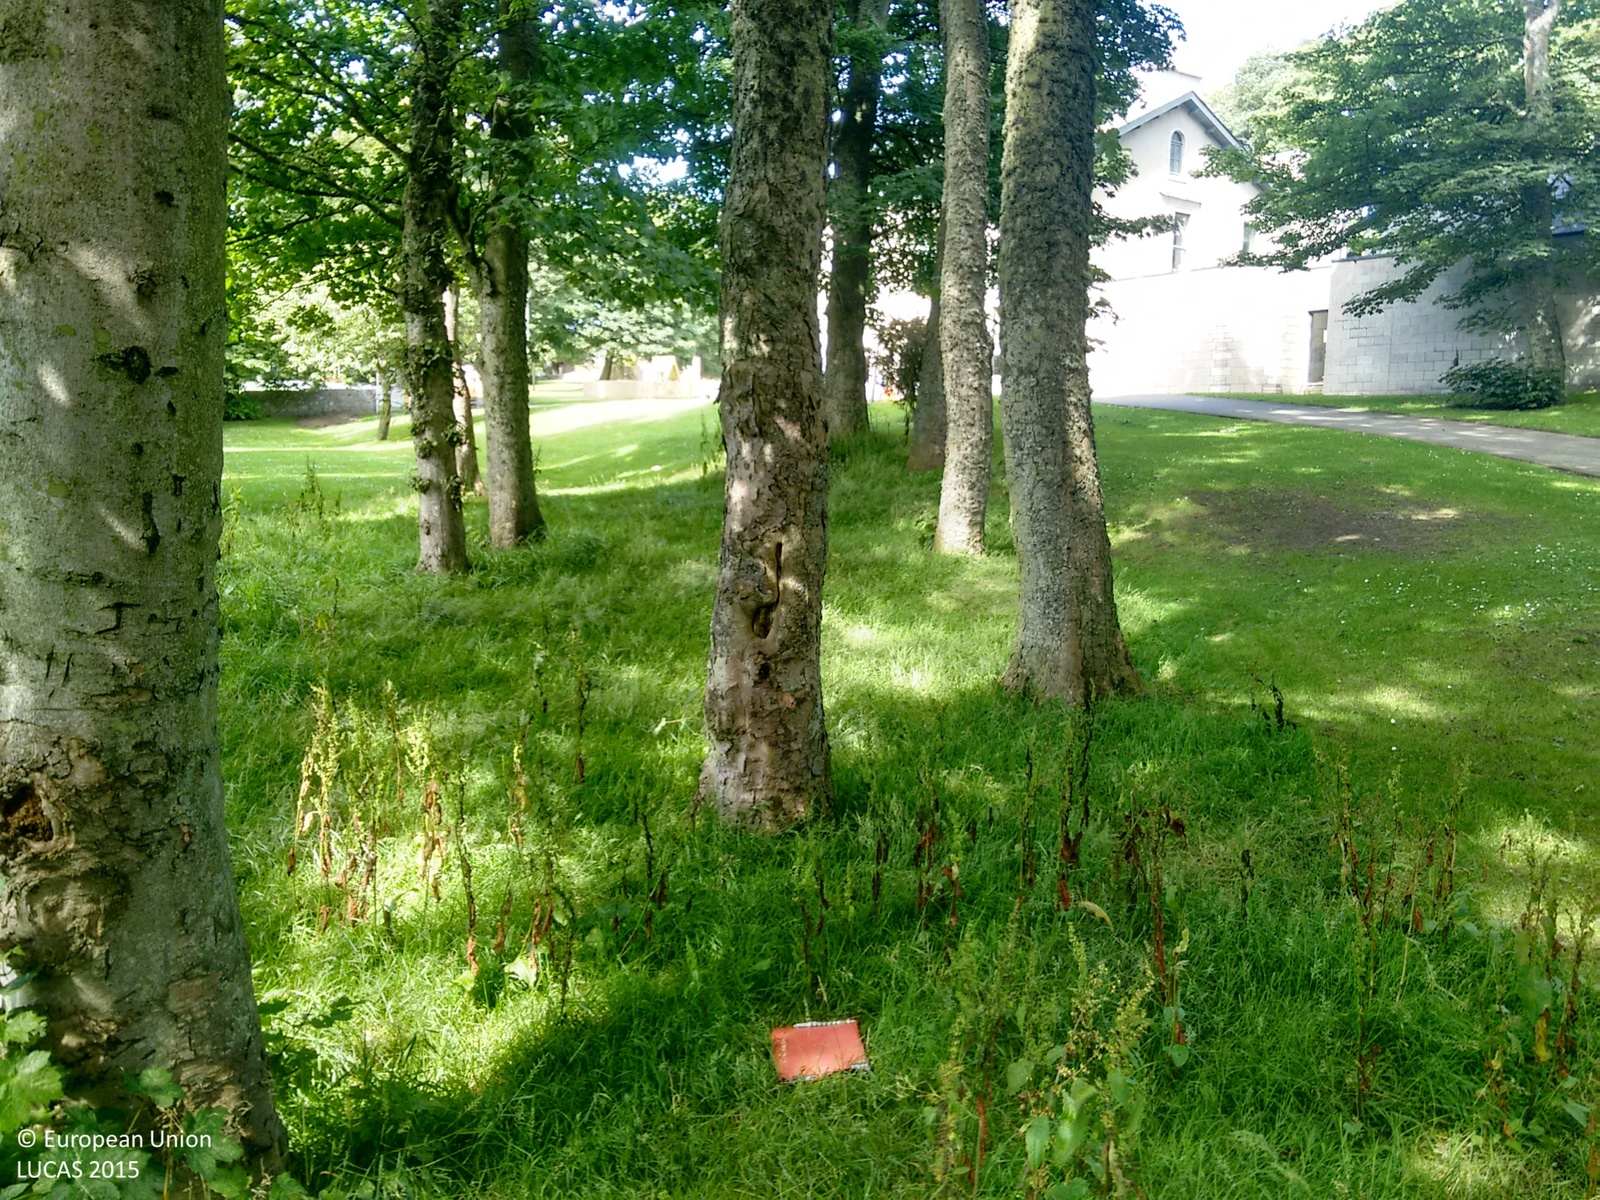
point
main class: Woodland
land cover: Broadleaved woodland
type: exotic forest
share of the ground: > 75 %
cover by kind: broadleaved forest trees 90 %, herbaceous plants 5 %, consolidated bare surface 5 %
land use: Residential
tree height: > 5 m
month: August
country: GB
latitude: 57.1071
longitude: -2.0840
